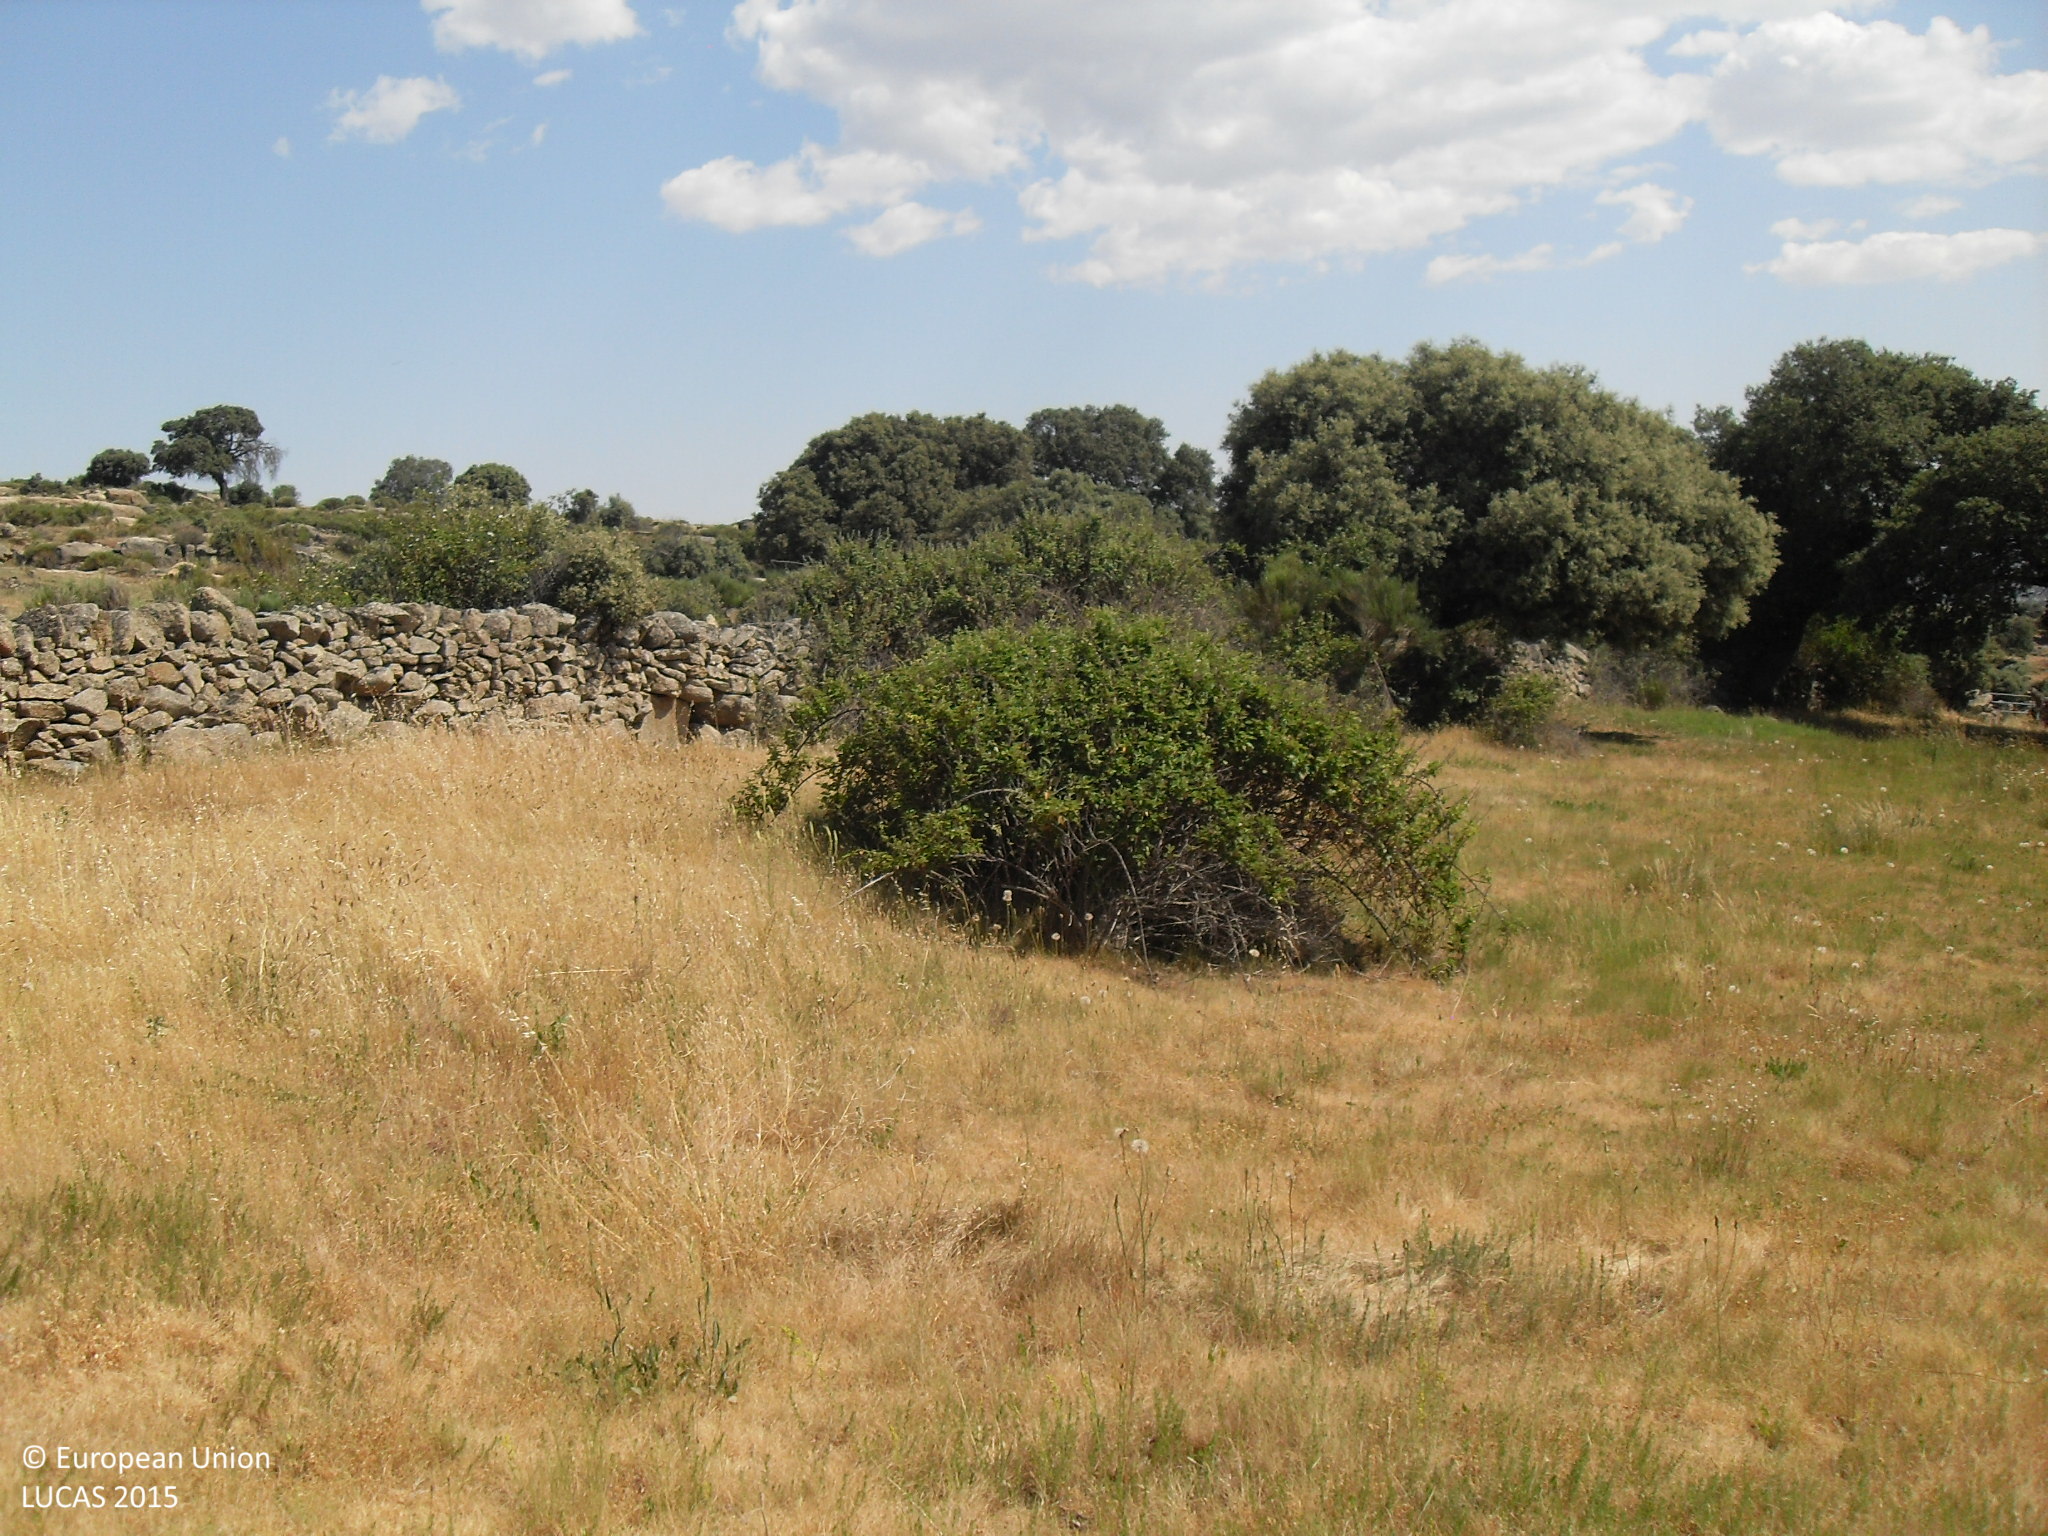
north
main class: Grassland
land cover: Grassland with sparse tree/shrub cover
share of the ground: > 75 %
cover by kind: herbaceous plants 95 %, broadleaved forest trees 5 %
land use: Agriculture (excluding fallow land and kitchen gardens)
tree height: < 5 m
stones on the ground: < 10 %
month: June
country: ES
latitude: 40.4704
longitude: -5.5542
